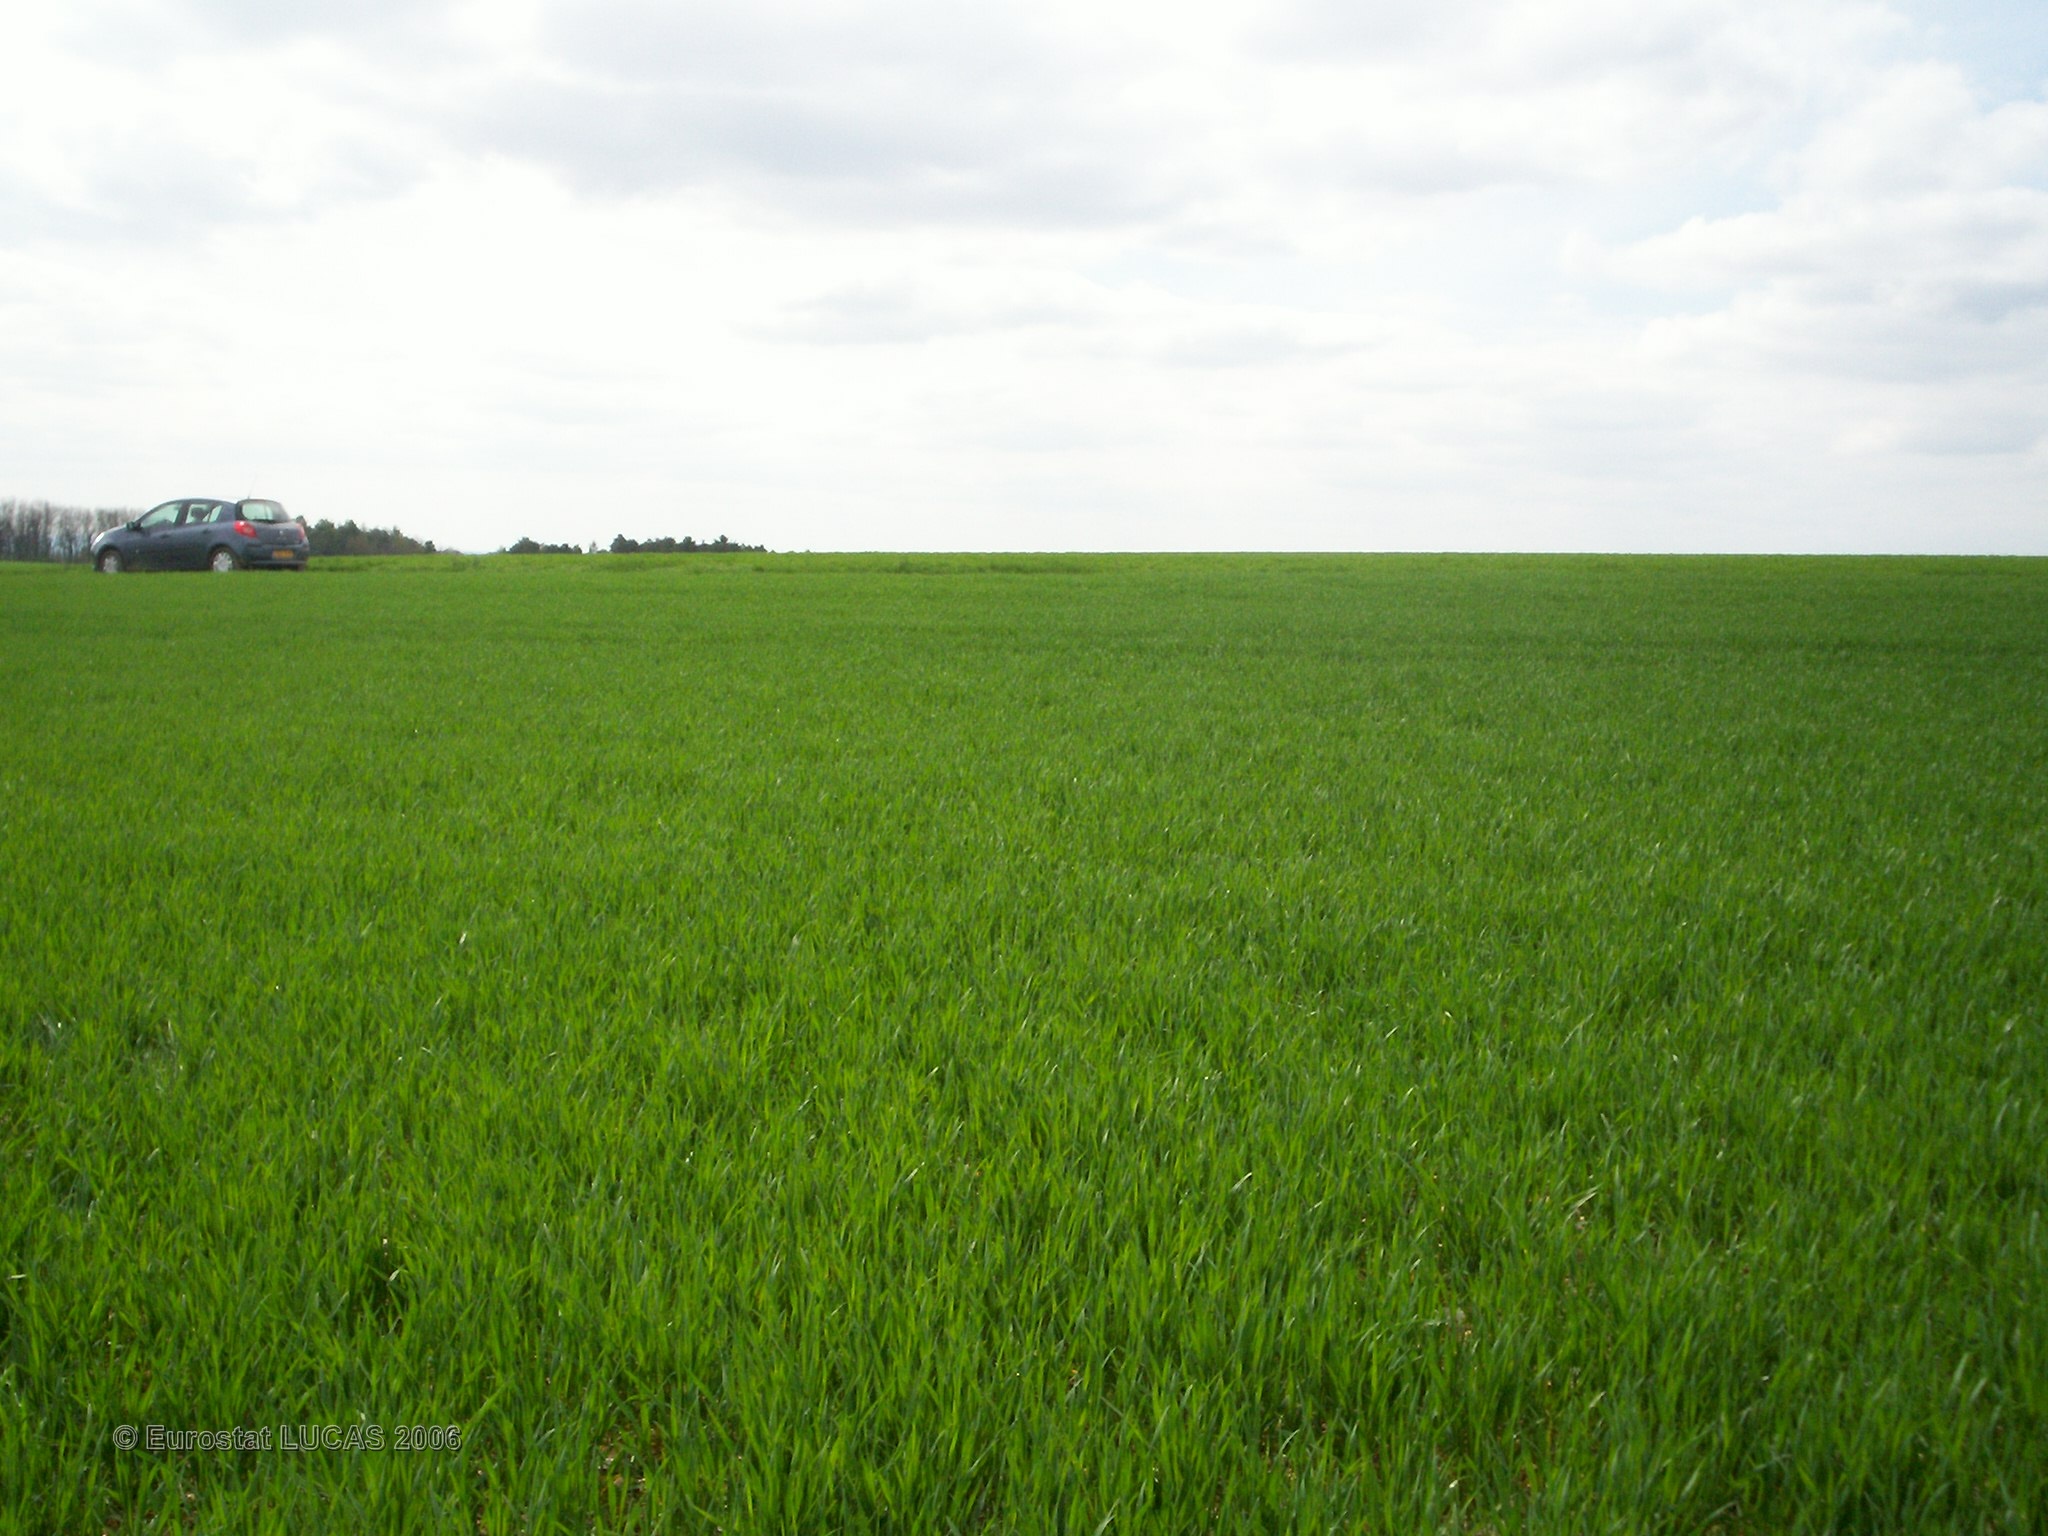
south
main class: Cropland
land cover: Common wheat
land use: Agriculture (excluding fallow land and kitchen gardens)
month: April
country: FR
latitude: 47.8822
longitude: 4.0464
